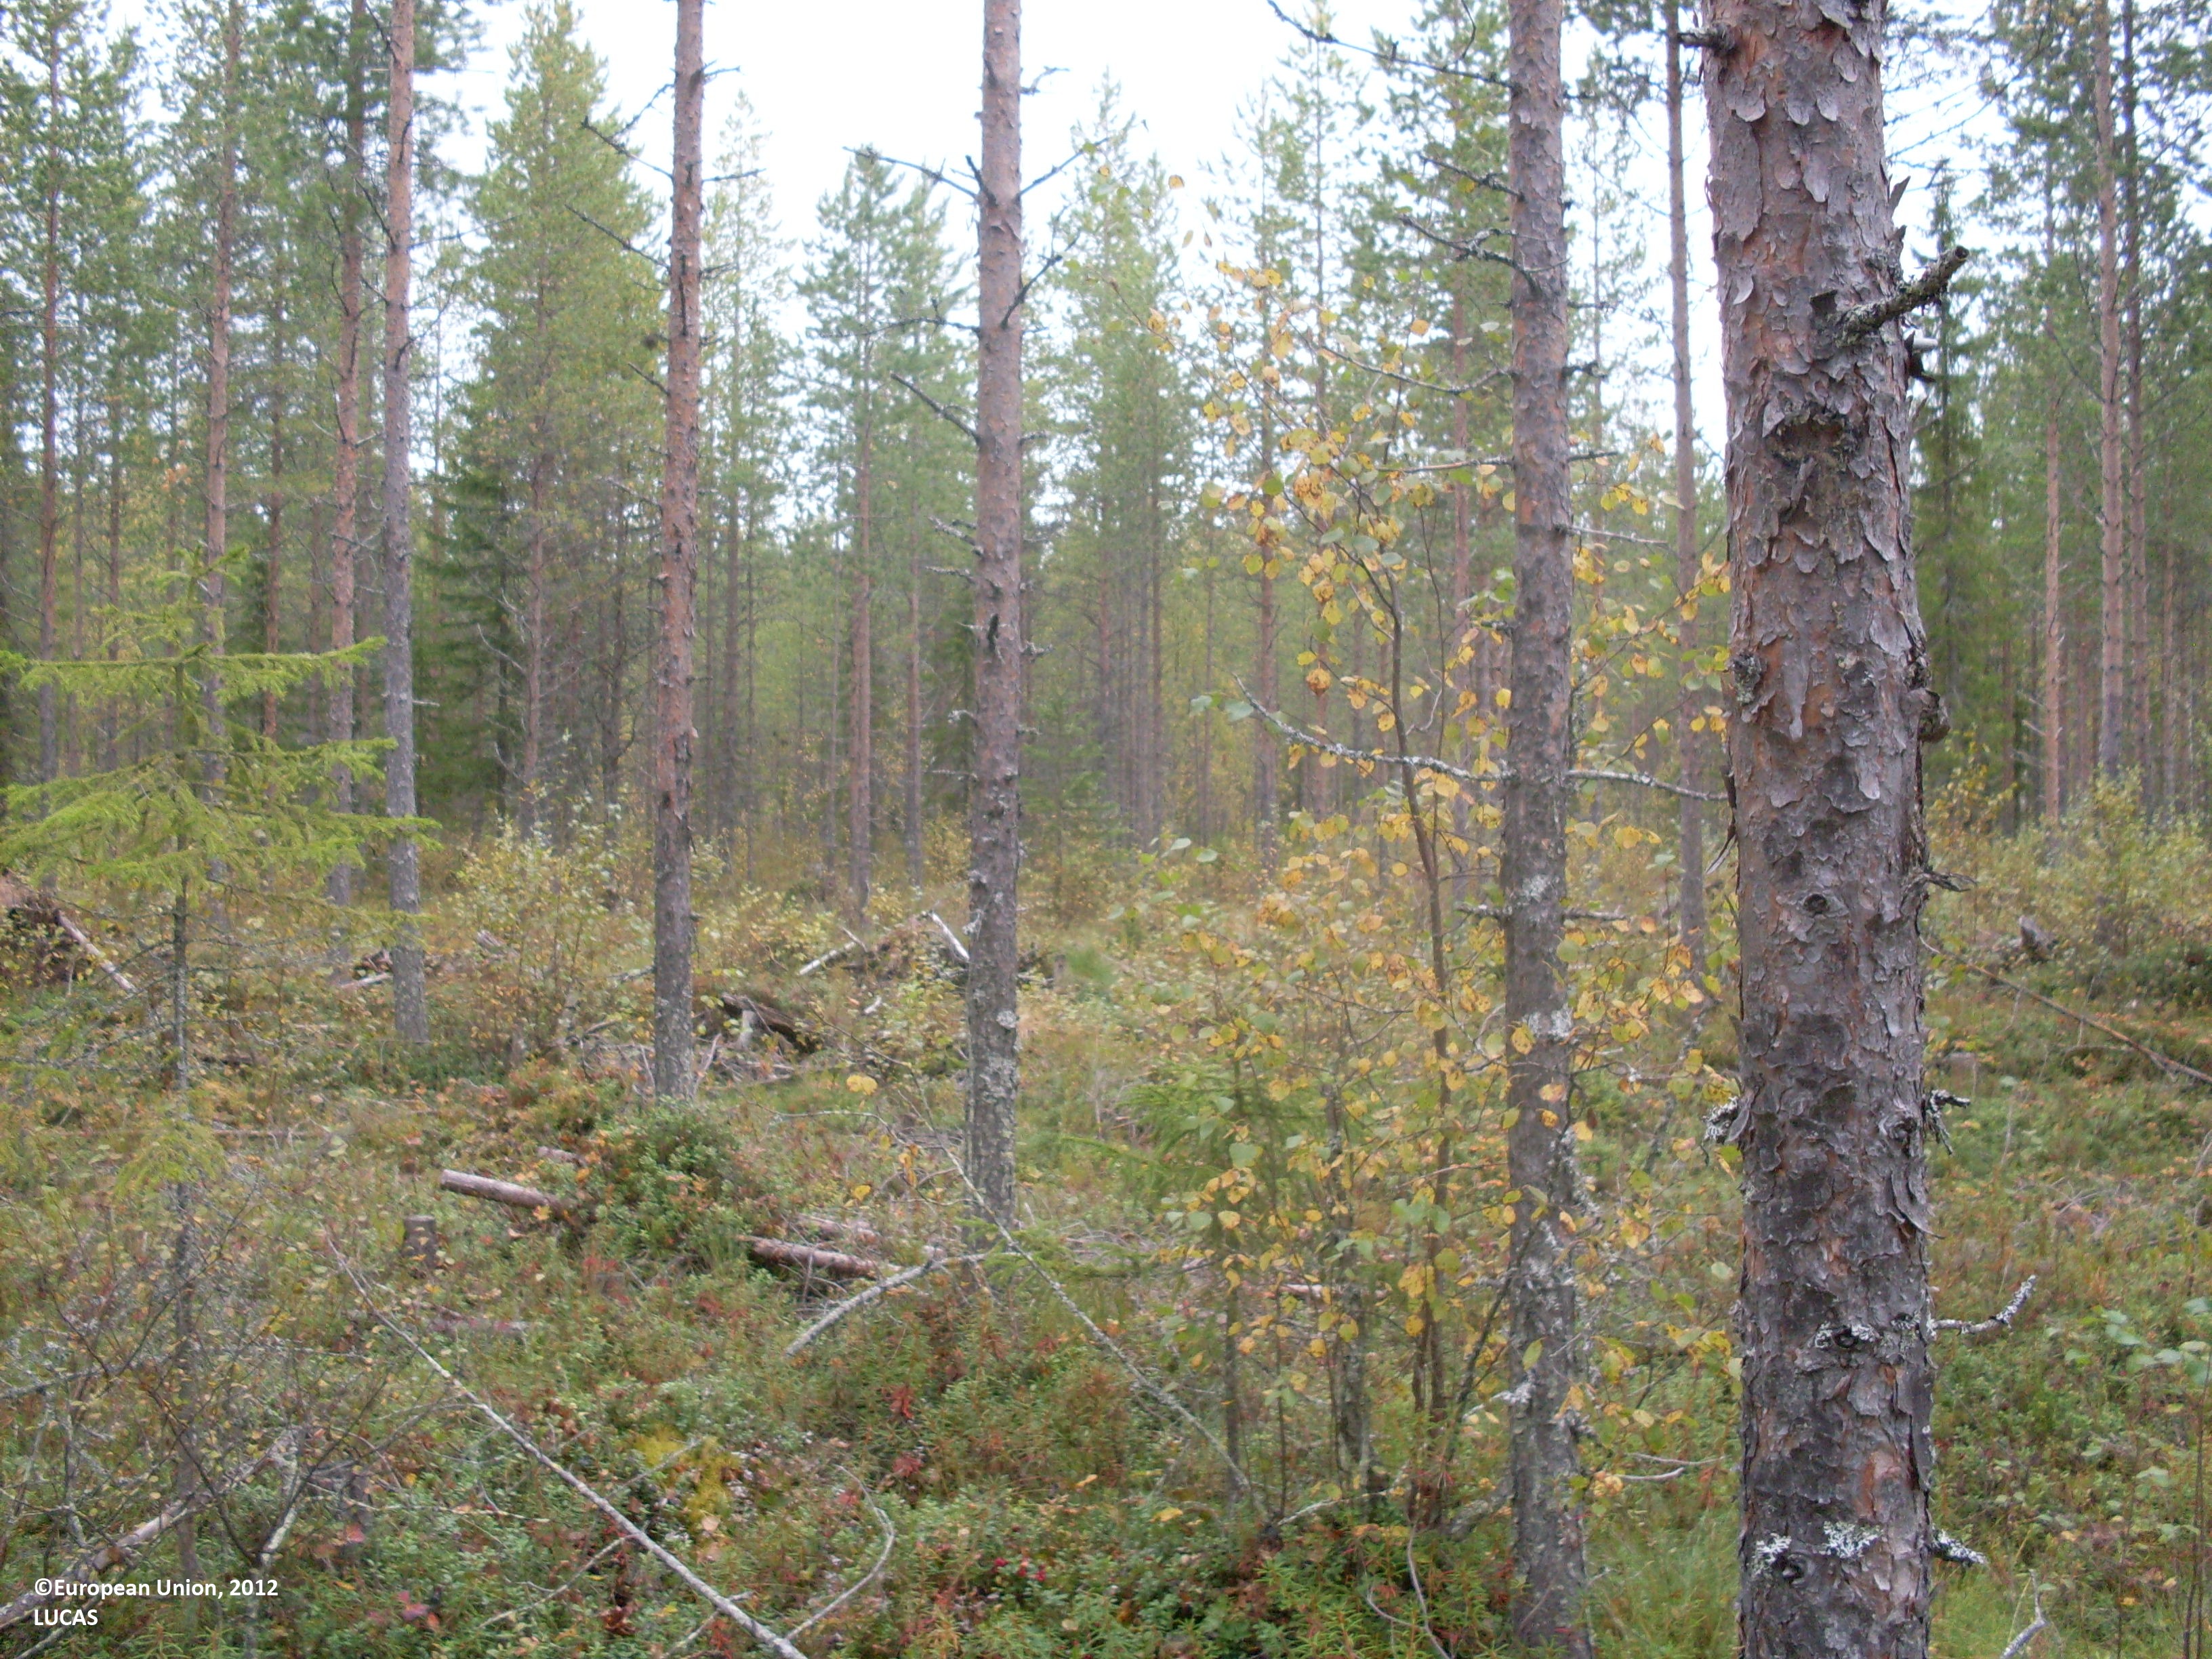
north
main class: Woodland
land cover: Pine dominated coniferous woodland
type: boreal forest
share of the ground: > 75 %
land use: Forestry
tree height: > 5 m
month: September
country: FI
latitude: 64.0416
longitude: 29.7010
